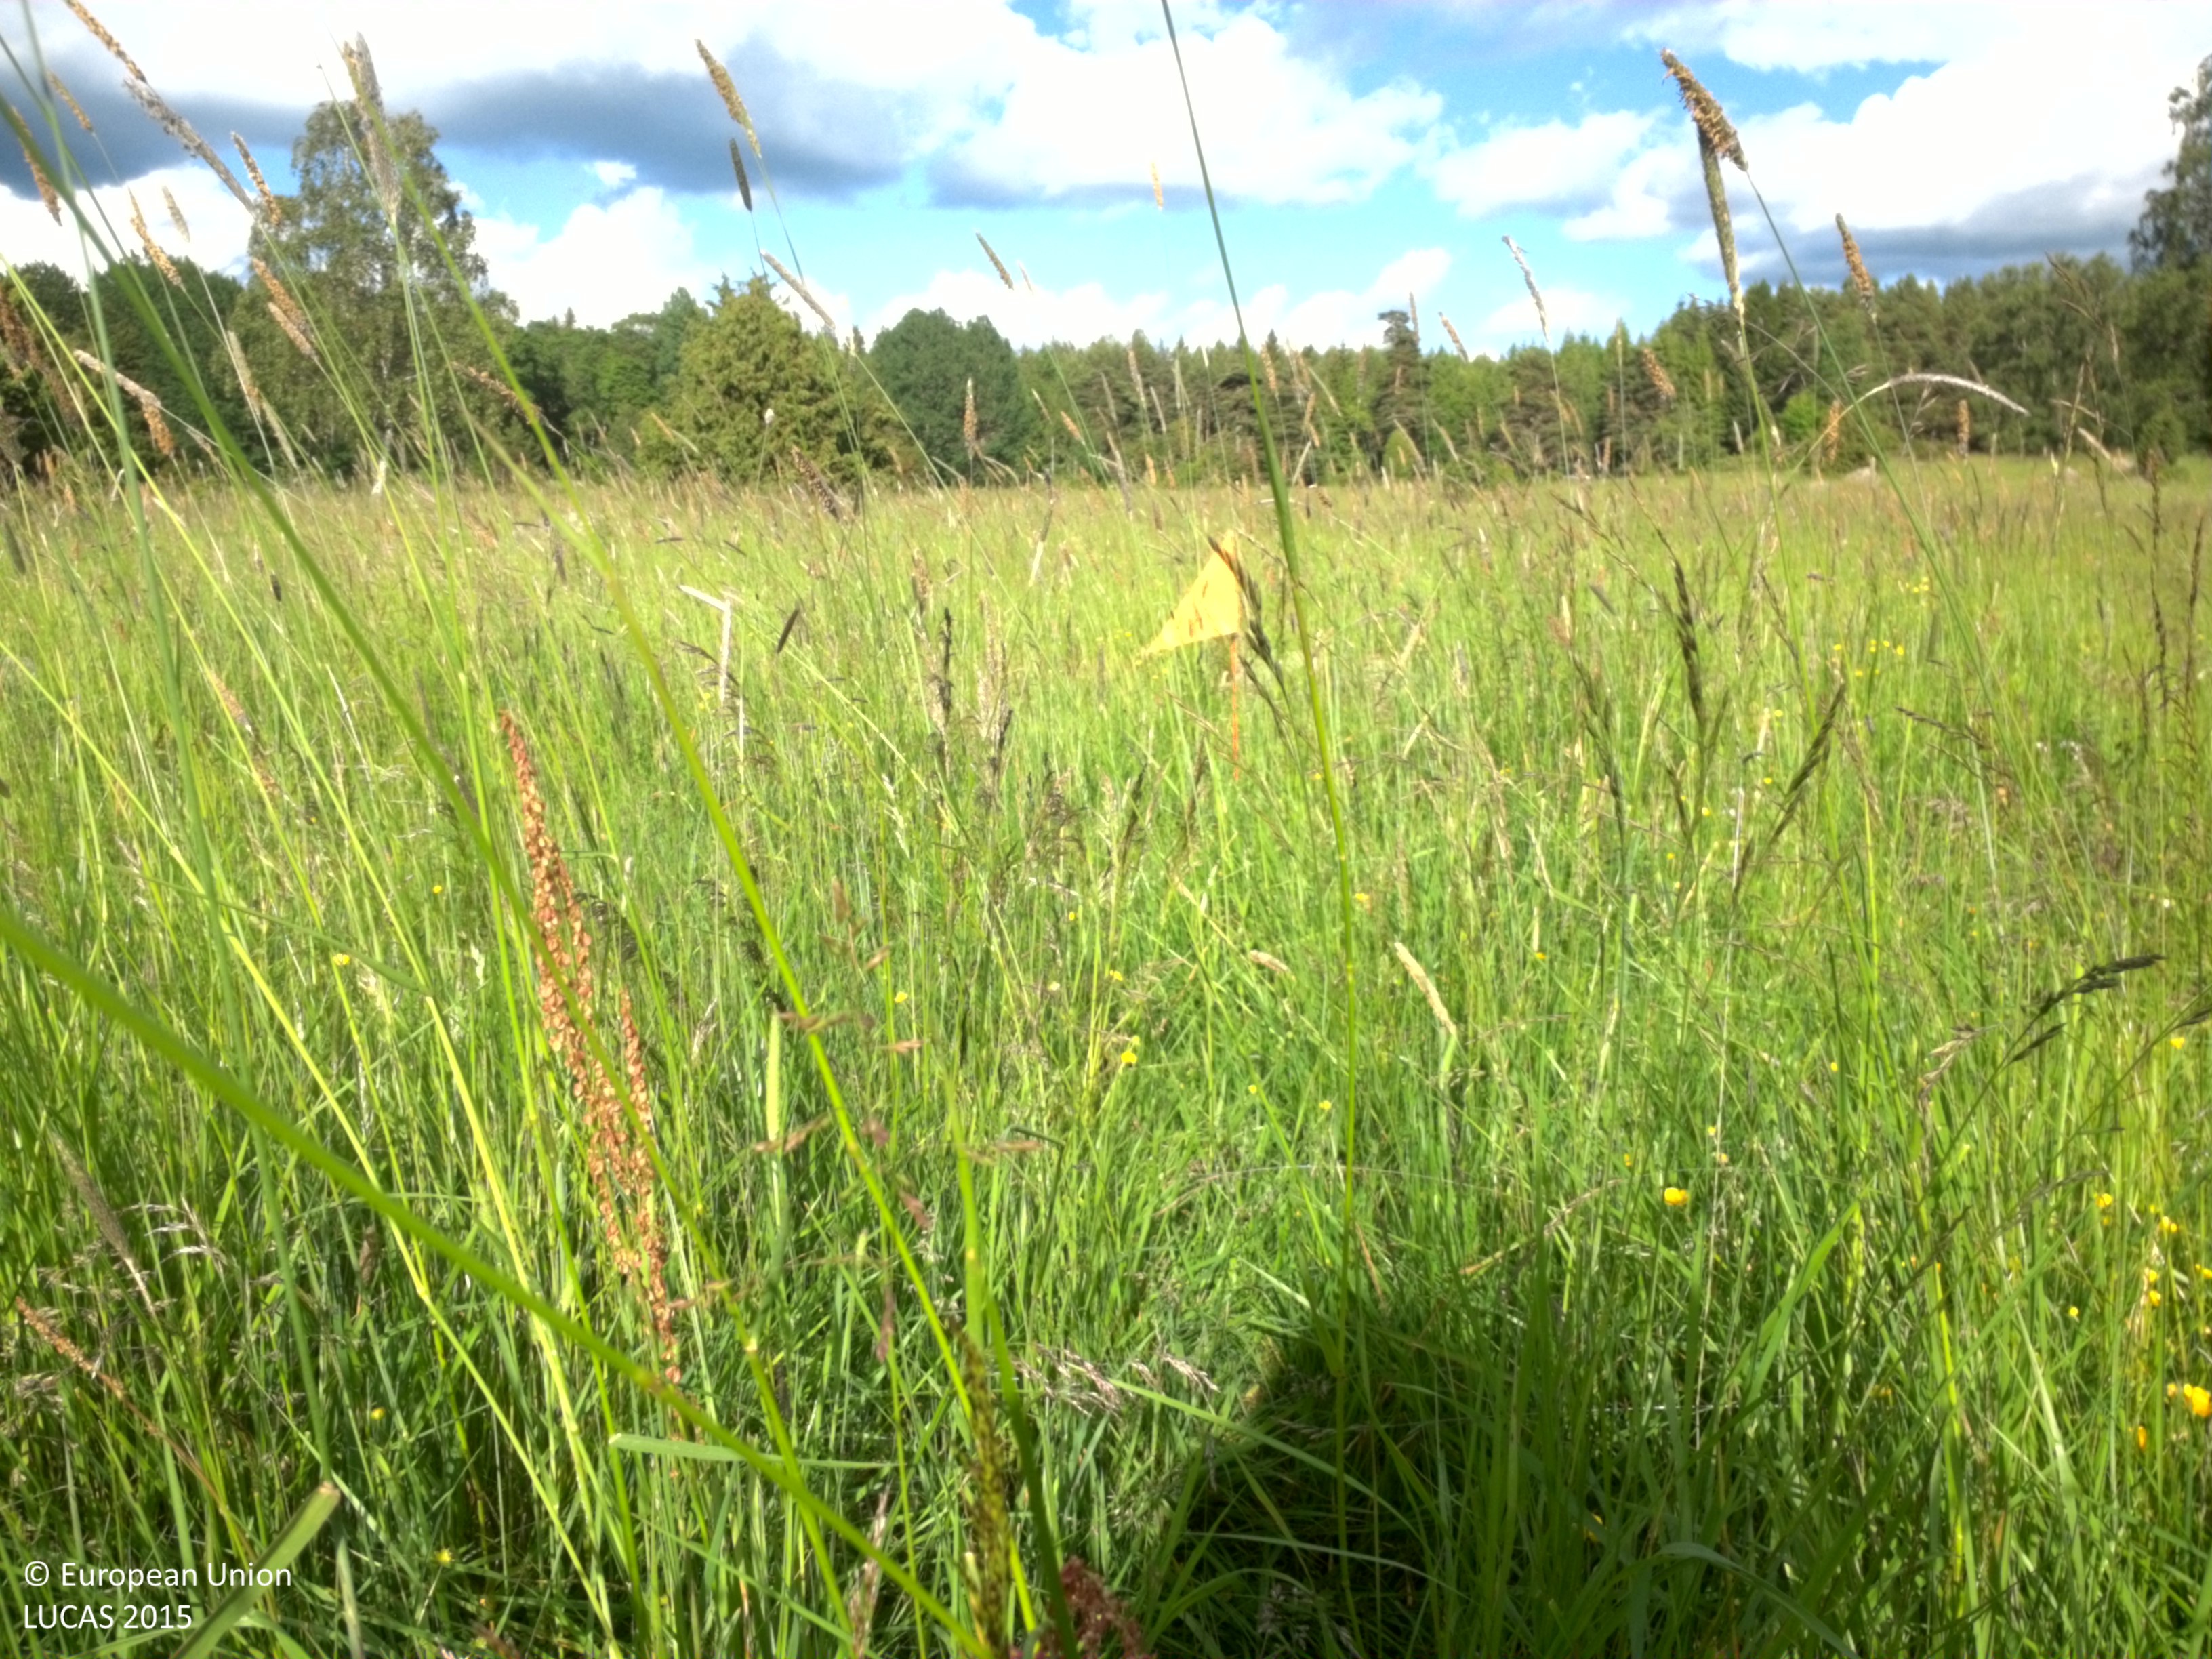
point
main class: Grassland
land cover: Grassland with sparse tree/shrub cover
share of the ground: 10 - 25 %
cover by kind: herbaceous plants 80 %, lichens and mosses 10 %, coniferous forest trees 5 %, shrubs 5 %
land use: Agriculture (excluding fallow land and kitchen gardens)
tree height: > 5 m
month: June
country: SE
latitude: 59.7431
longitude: 17.8779
